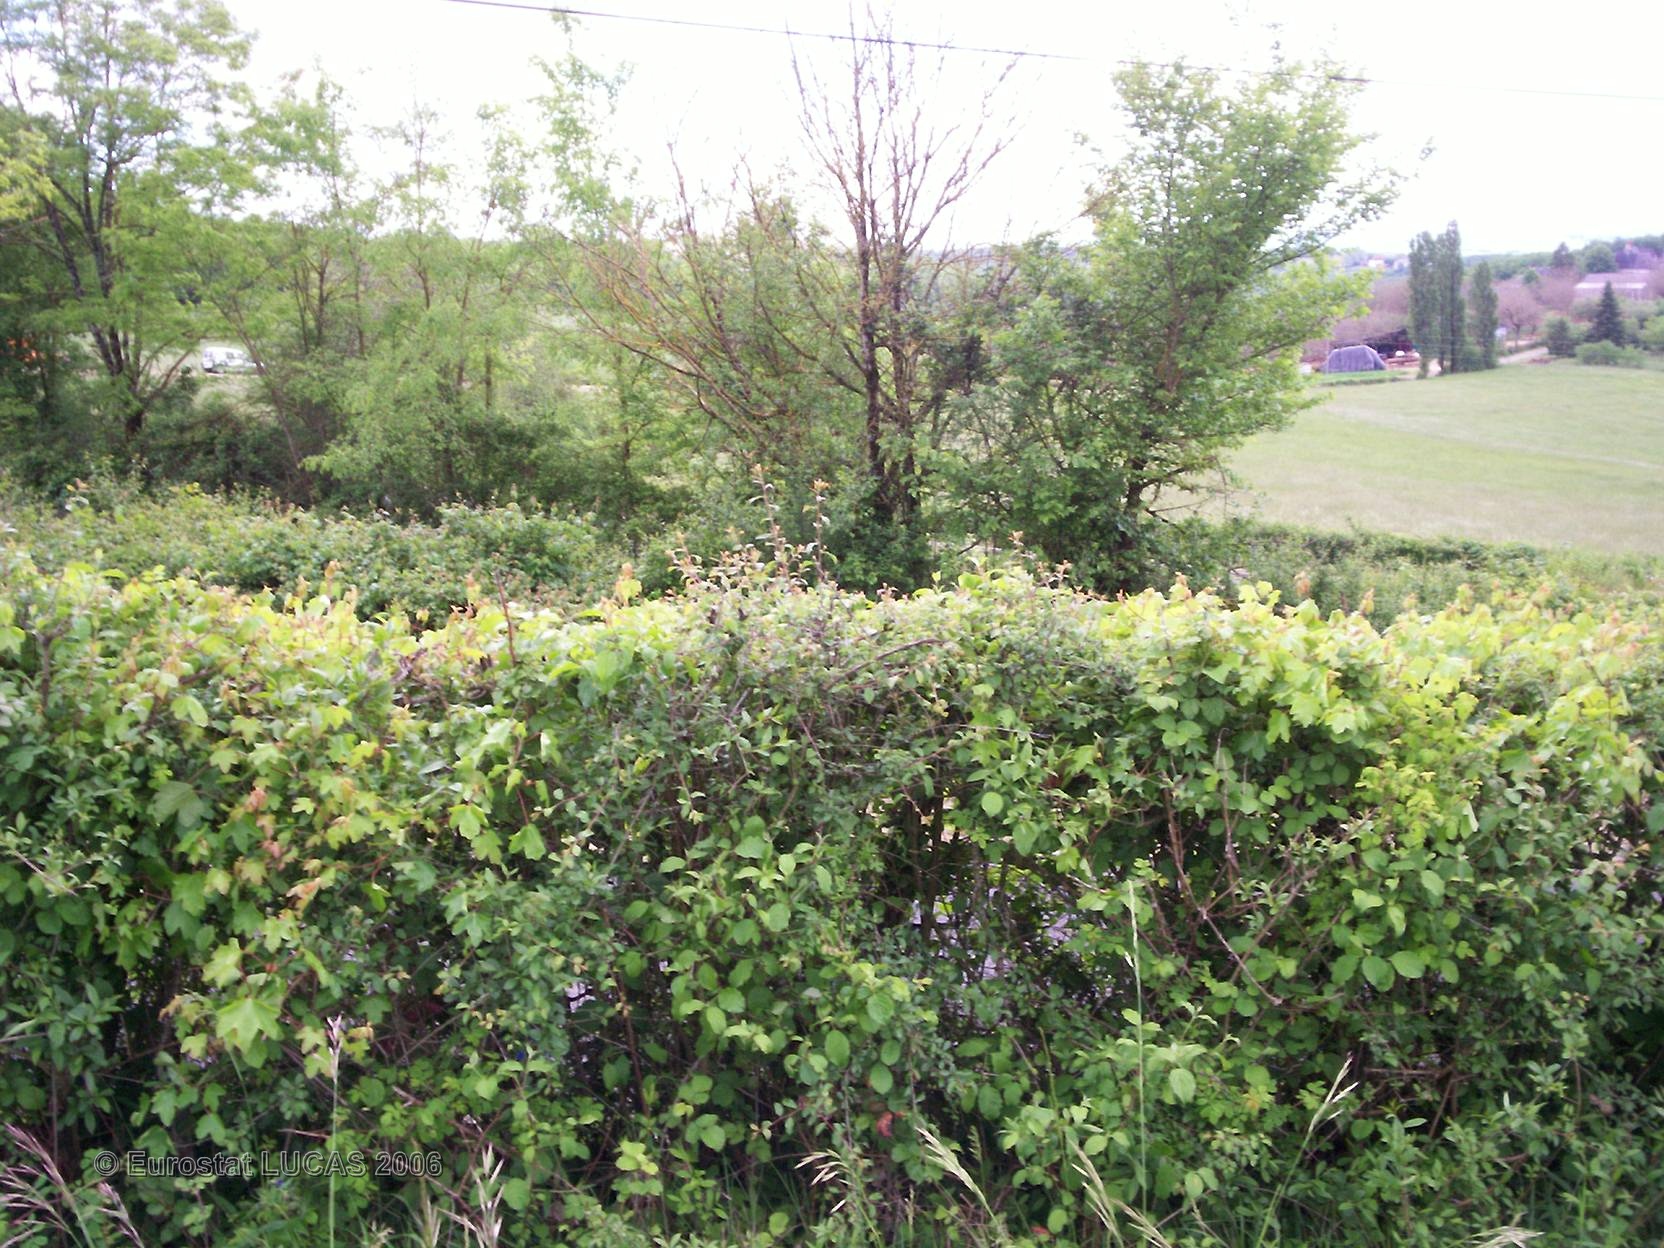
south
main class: Grassland
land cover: Grassland without tree/shrub cover
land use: Agriculture (excluding fallow land and kitchen gardens)
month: May
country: FR
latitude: 45.1096
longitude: 1.3133
